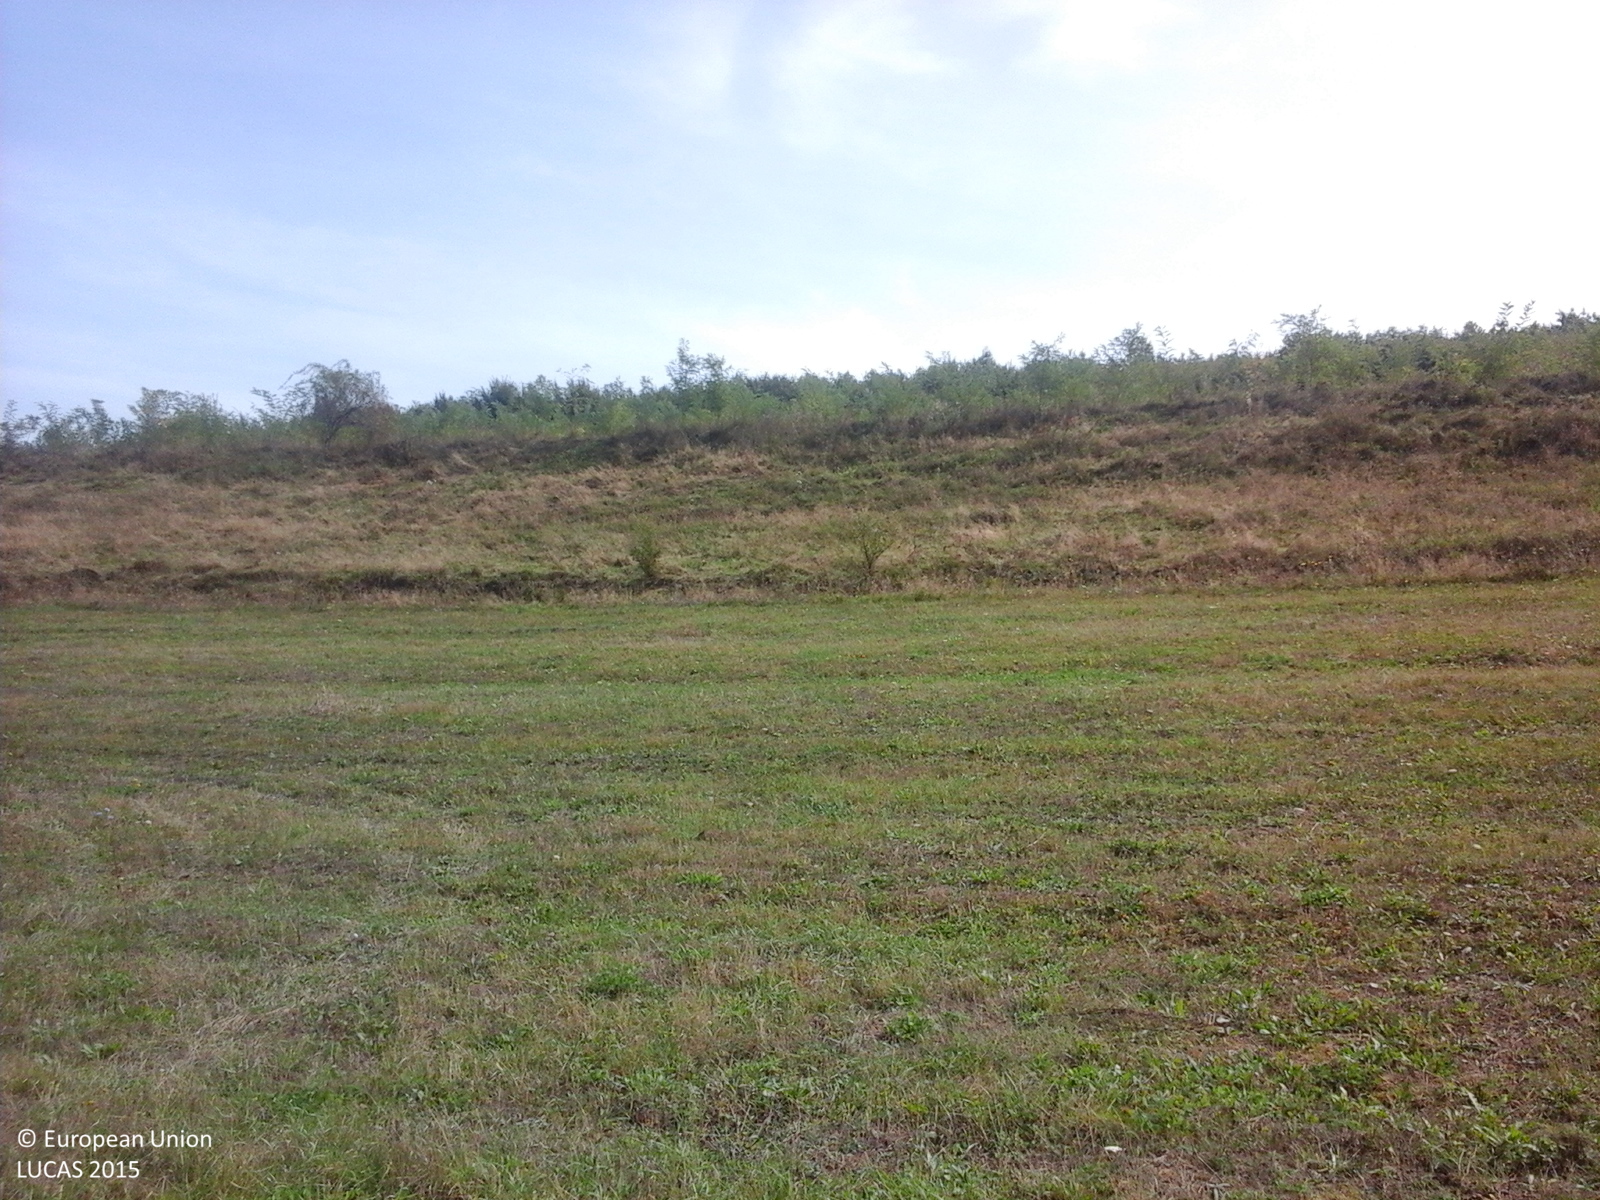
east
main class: Grassland
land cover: Grassland without tree/shrub cover
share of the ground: > 75 %
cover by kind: herbaceous plants 100 %
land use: Agriculture (excluding fallow land and kitchen gardens)
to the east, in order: Grassland without tree/shrub cover; Grassland with sparse tree/shrub cover; Broadleaved woodland; Tracks; Broadleaved woodland
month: September
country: RO
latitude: 46.9007
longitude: 24.1679
